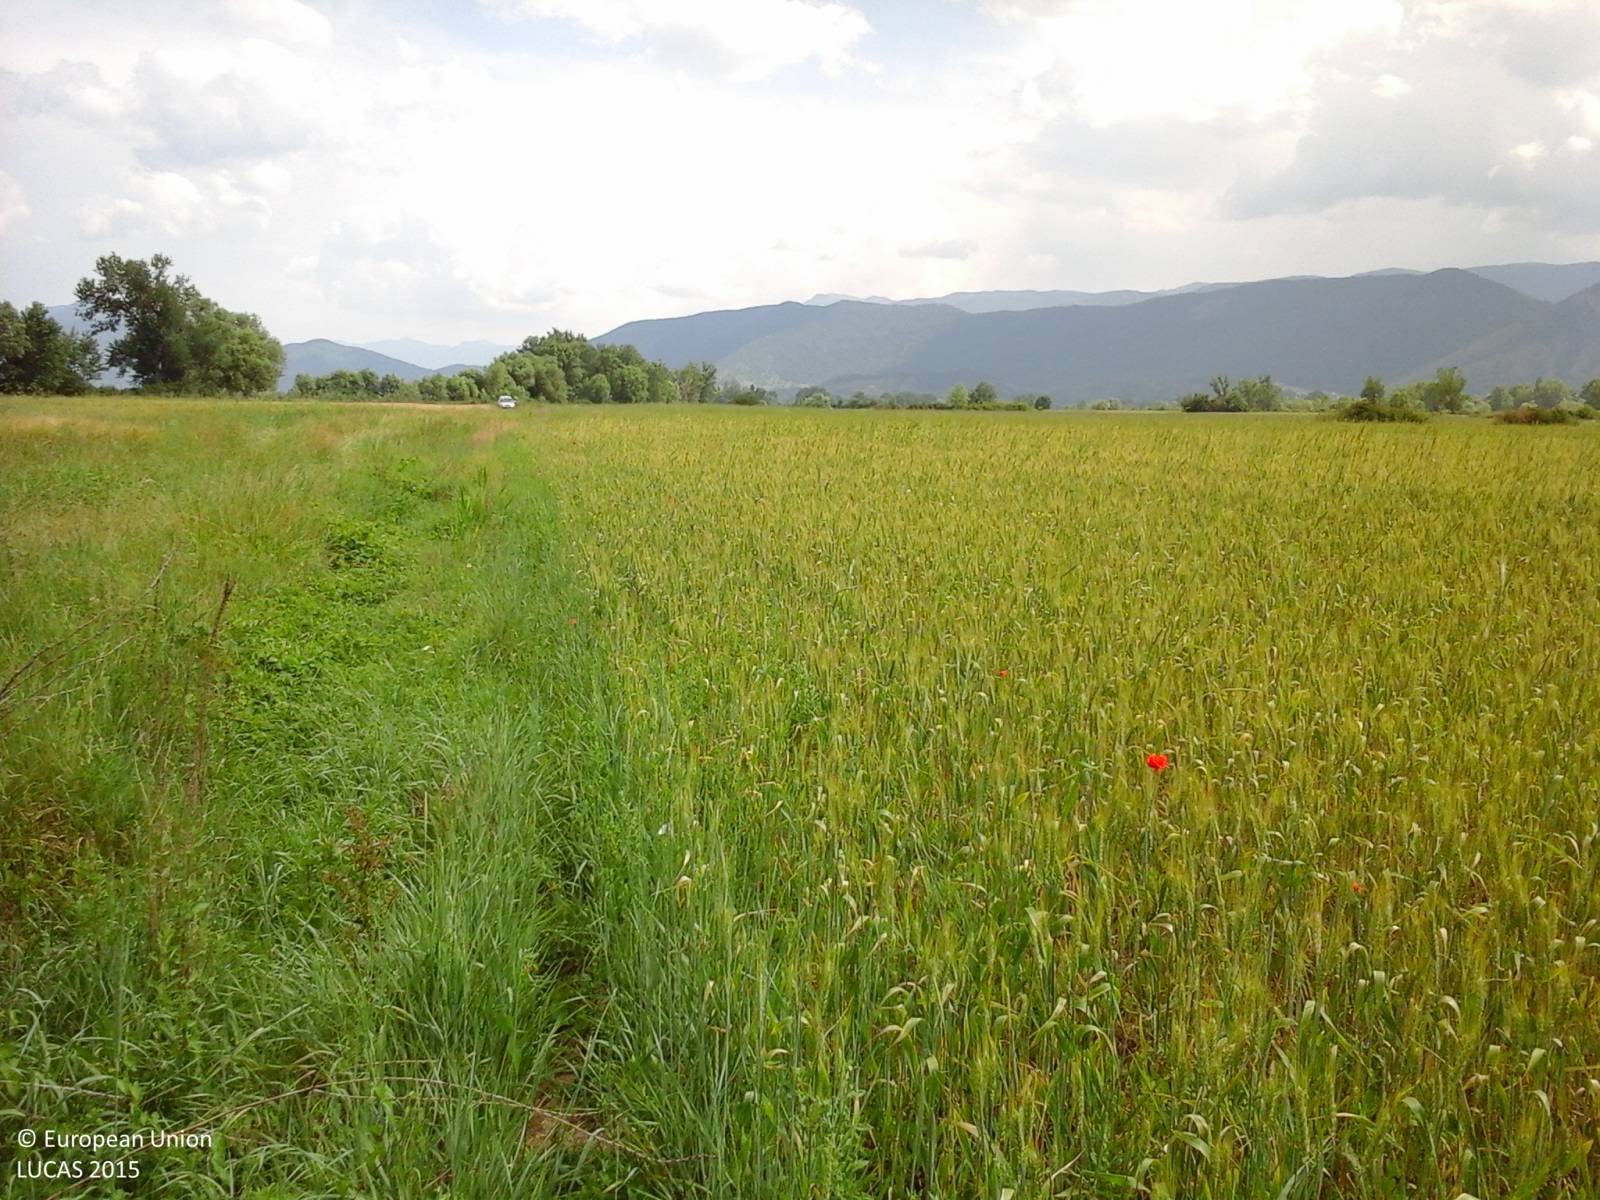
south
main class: Cropland
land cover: Common wheat
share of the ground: > 75 %
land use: Agriculture (excluding fallow land and kitchen gardens)
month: June
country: IT
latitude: 42.0559
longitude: 13.3597
